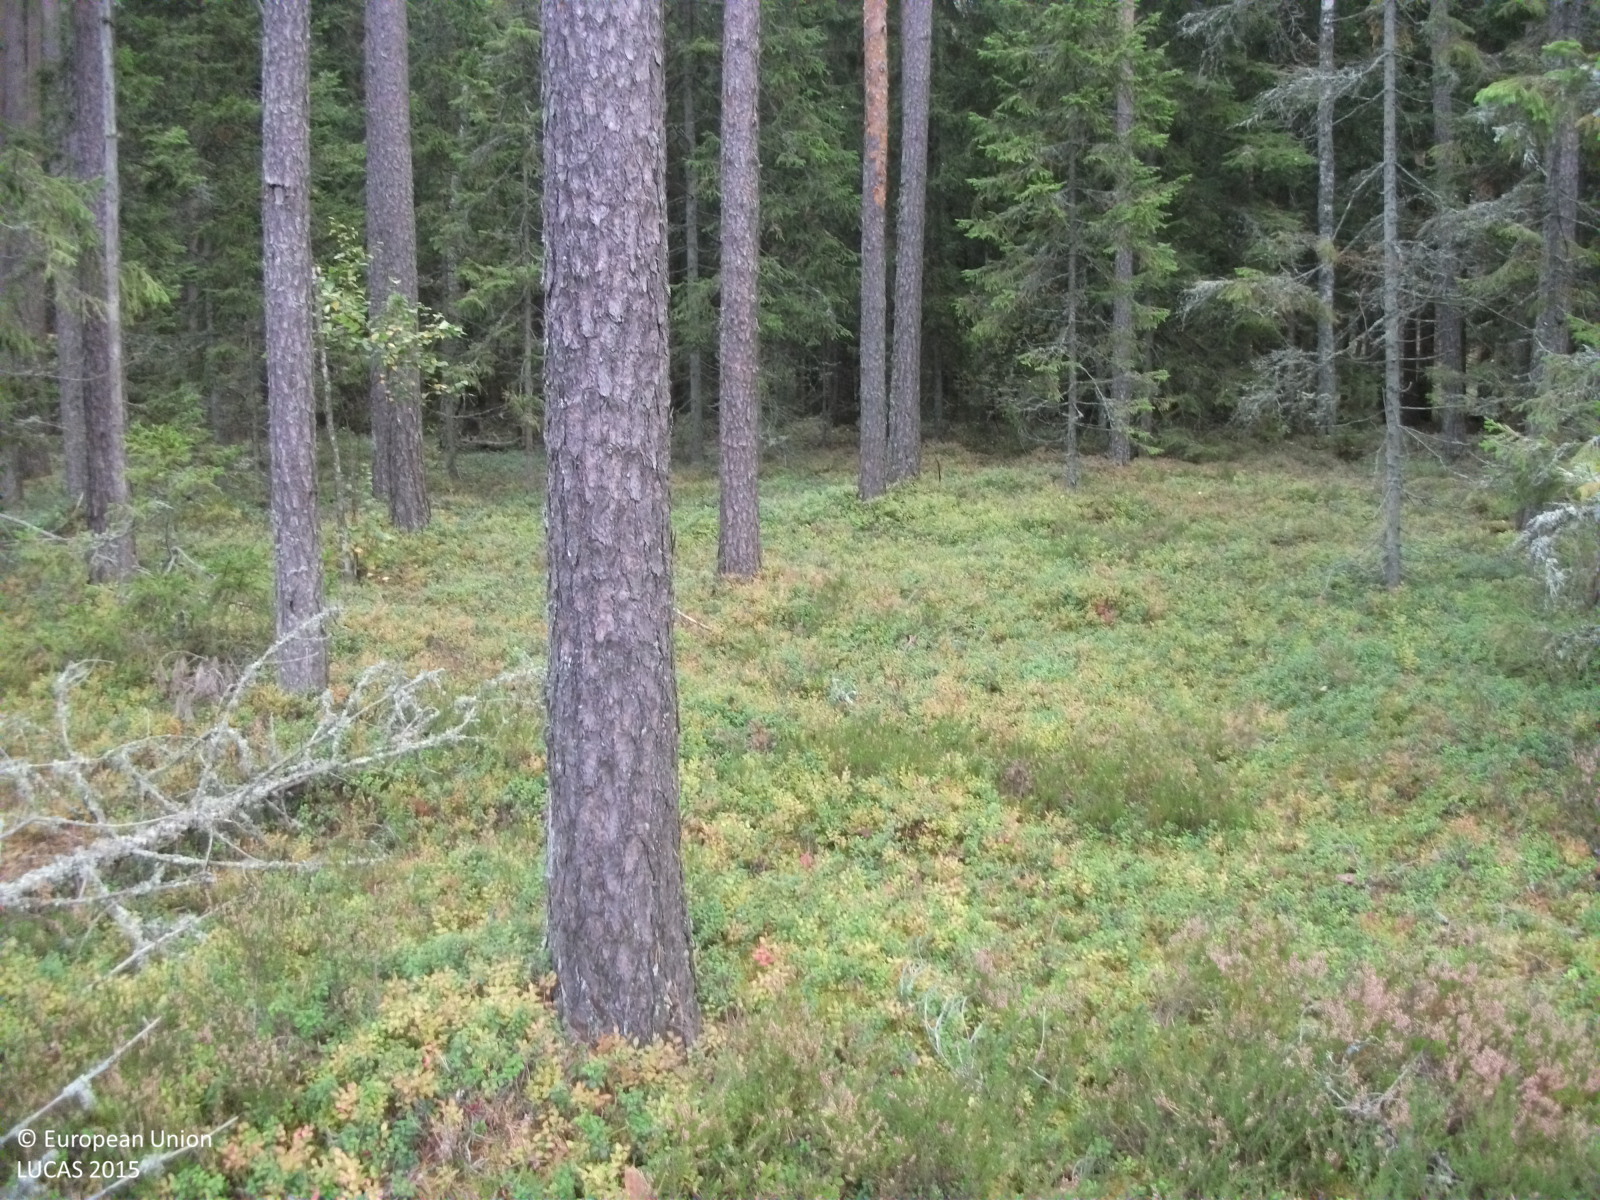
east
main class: Woodland
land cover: Pine dominated coniferous woodland
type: hemiboreal forest and nemoral coniferous forest and mixed broadleaved-coniferous forest
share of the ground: > 75 %
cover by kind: coniferous forest trees 80 %, lichens and mosses 15 %, herbaceous plants 5 %
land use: Forestry
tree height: > 5 m
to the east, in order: Pine dominated coniferous woodland; Spruce dominated coniferous woodland; Pine dominated coniferous woodland; Ditches and canals; Pine dominated coniferous woodland; Other coniferous woodland; Shrubland with sparse tree cover
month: September
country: LV
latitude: 57.6876
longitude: 24.4640
